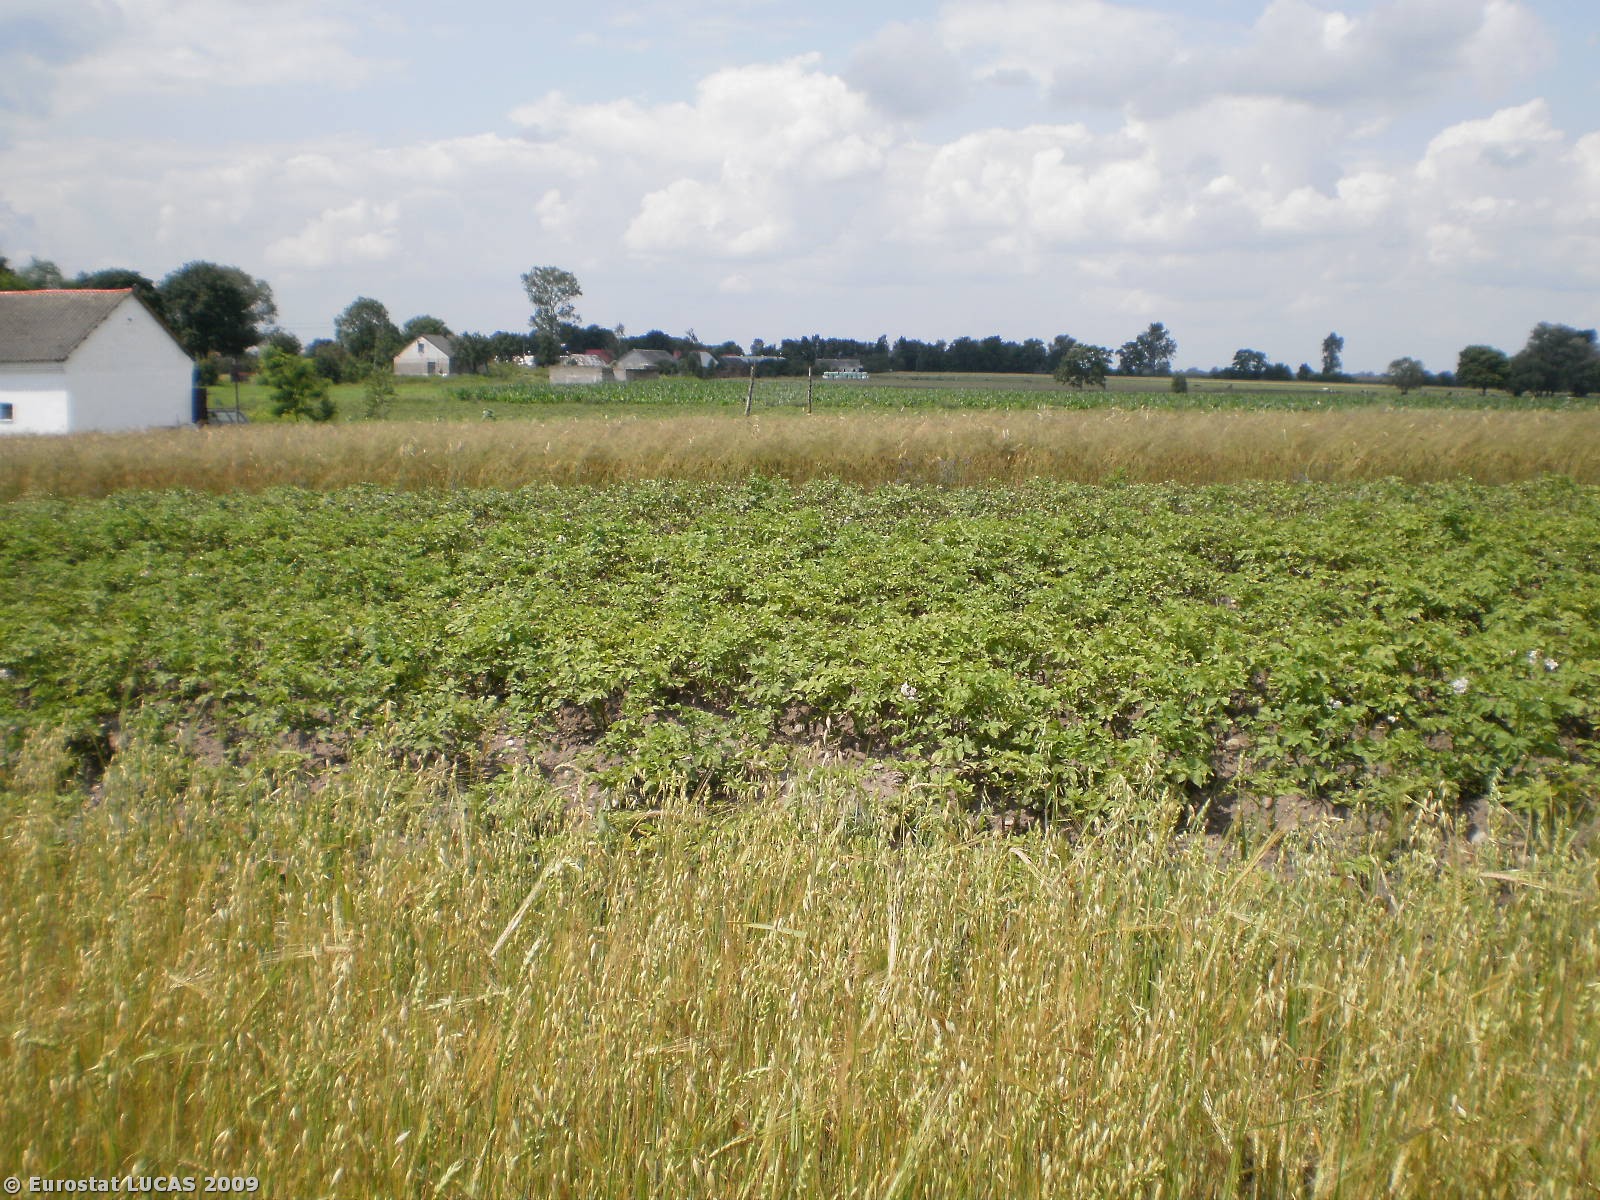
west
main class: Cropland
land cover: Mixed cereals for fodder
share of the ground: > 75 %
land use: Agriculture (excluding fallow land and kitchen gardens)
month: July
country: PL
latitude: 52.9342
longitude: 20.4066
